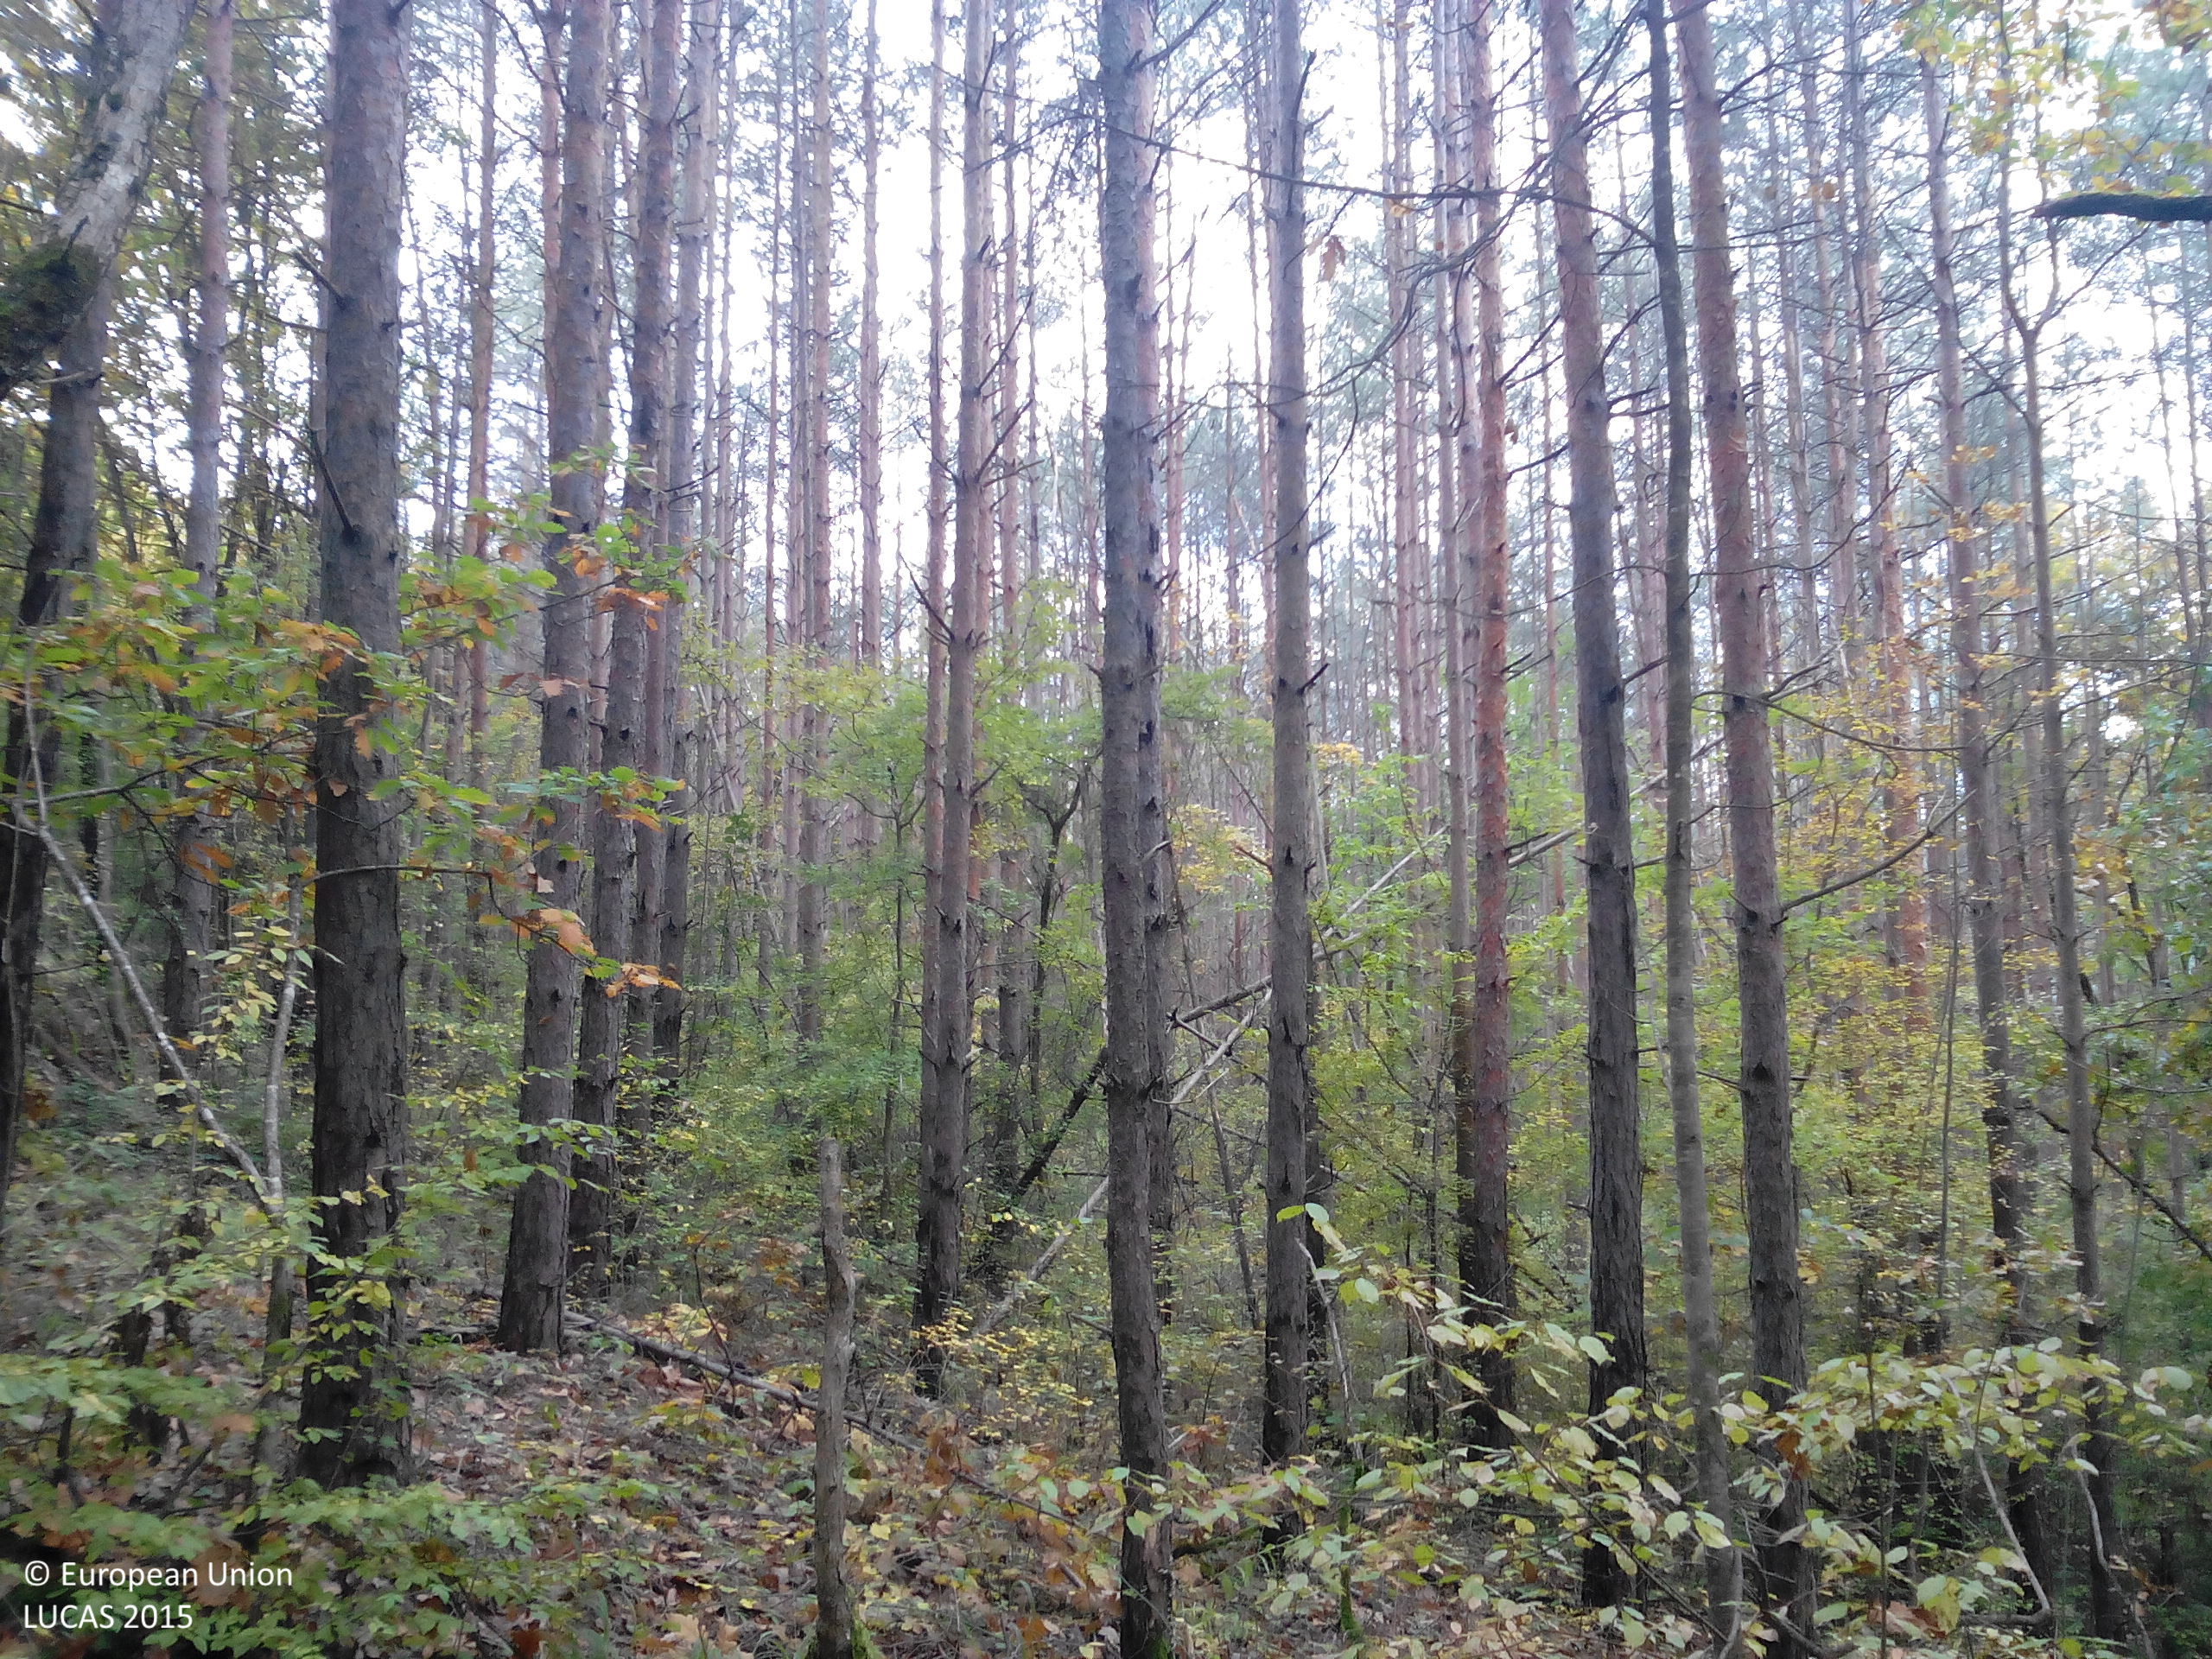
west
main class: Woodland
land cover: Other mixed woodland
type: acidophilous oak and oak-birch forest
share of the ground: > 75 %
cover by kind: broadleaved forest trees 70 %, coniferous forest trees 25 %, shrubs 5 %
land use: Forestry
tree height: > 5 m
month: October
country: BG
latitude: 43.0433
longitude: 23.9056
